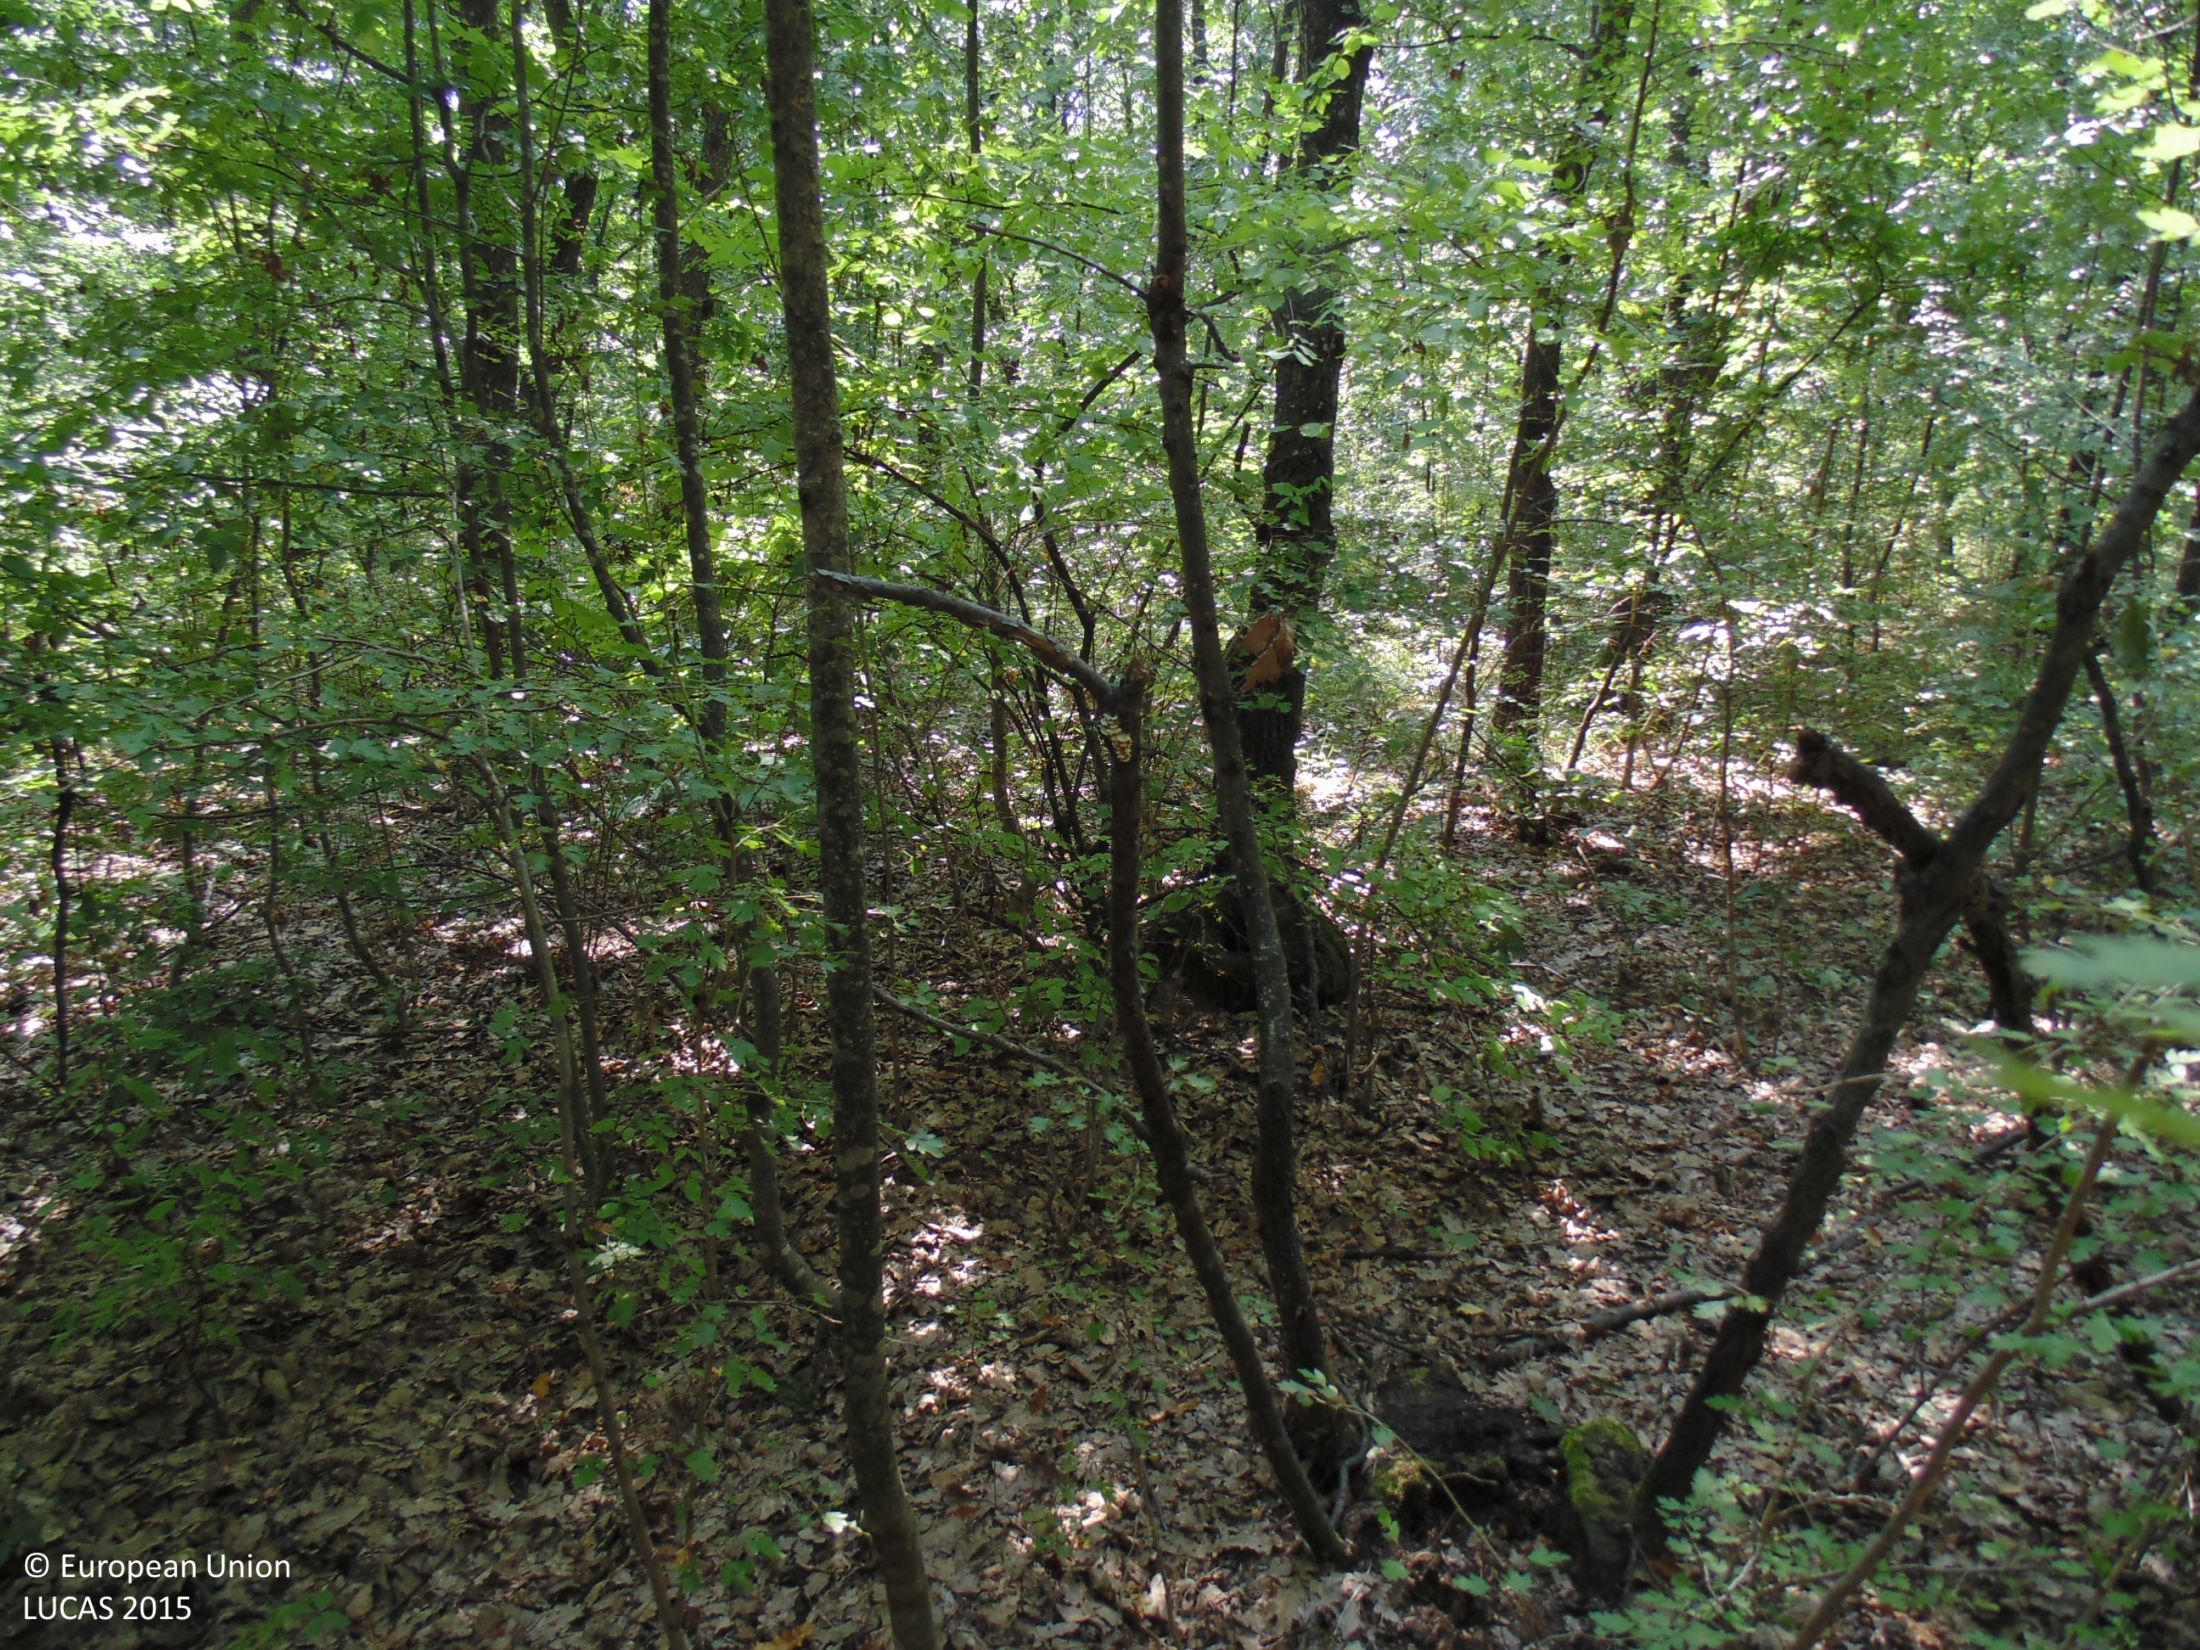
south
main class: Woodland
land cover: Broadleaved woodland
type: mesophytic deciduous forest
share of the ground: > 75 %
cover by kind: broadleaved forest trees 95 %, unconsolidated bare surface 5 %
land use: Forestry
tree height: > 5 m
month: August
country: BG
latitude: 43.9504
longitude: 27.4169
